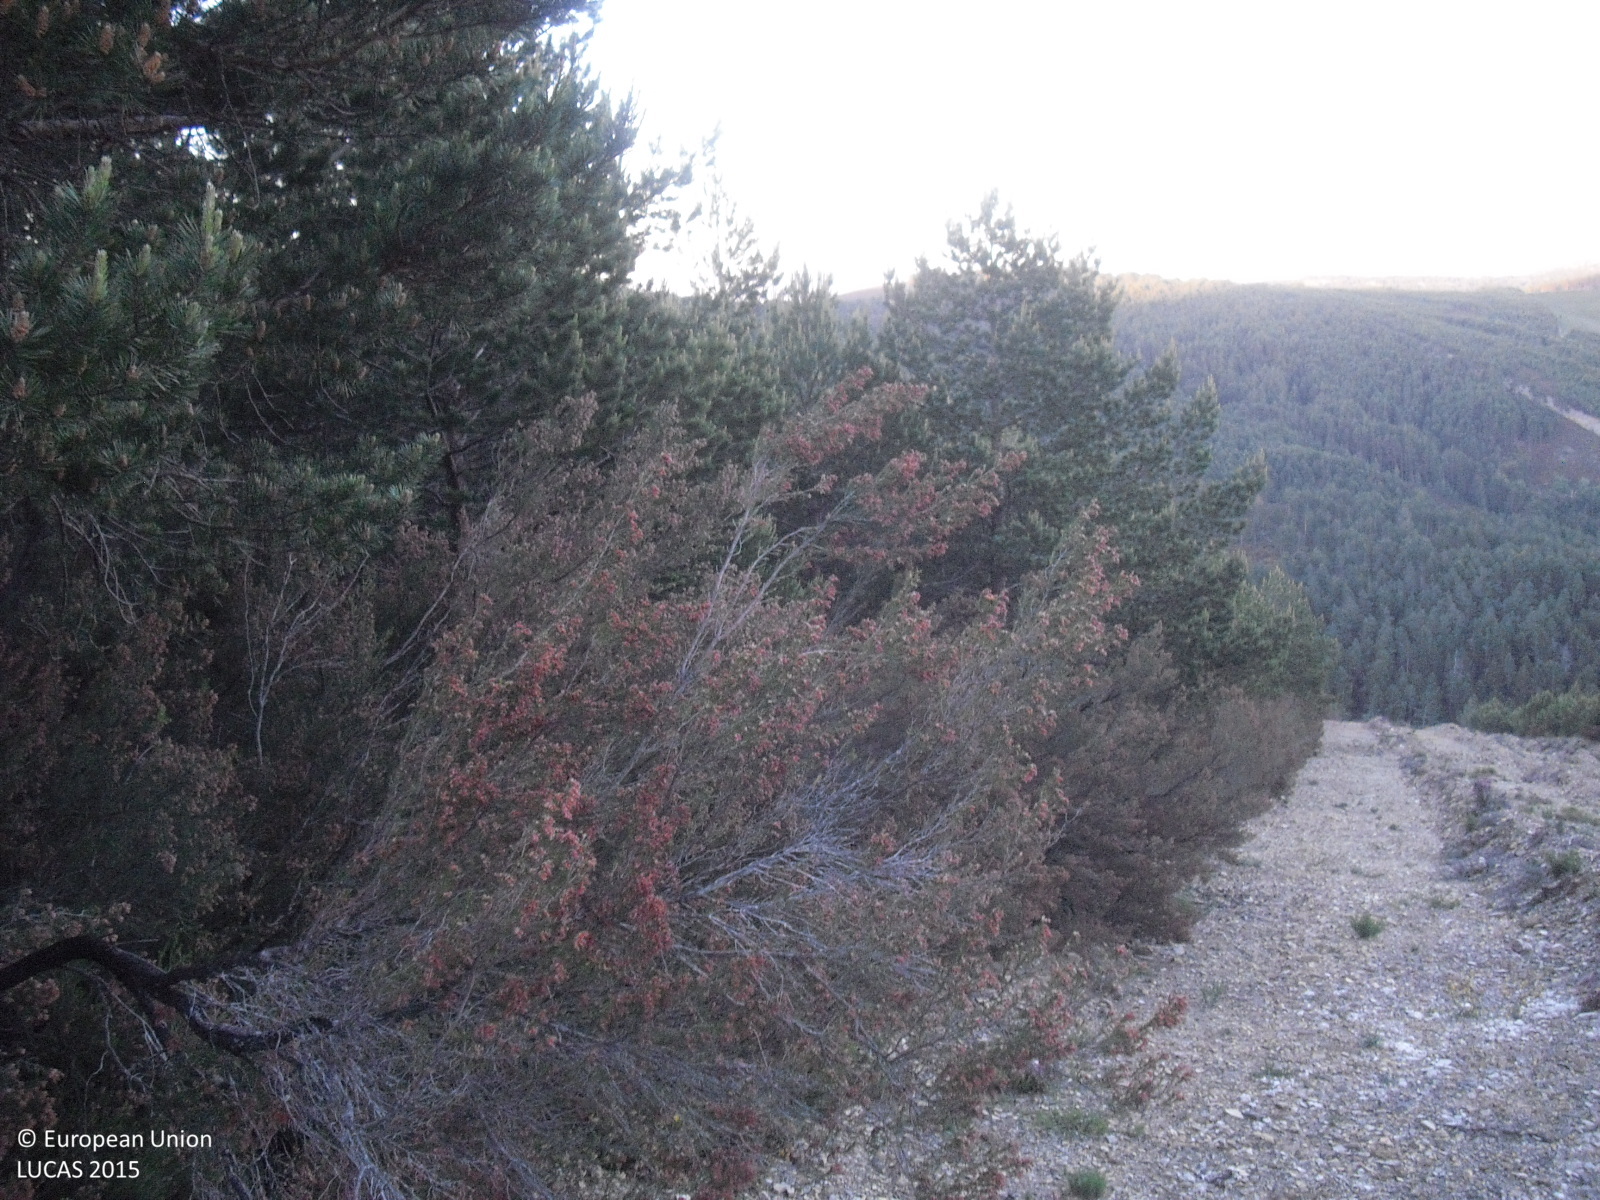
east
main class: Woodland
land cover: Pine dominated coniferous woodland
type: hemiboreal forest and nemoral coniferous forest and mixed broadleaved-coniferous forest
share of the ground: > 75 %
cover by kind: coniferous forest trees 80 %, shrubs 20 %
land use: Forestry
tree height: < 5 m
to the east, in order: Pine dominated coniferous woodland; Shruby margins; Ditches and canals; Paved roads, cycling and walking lanes; Shrubland without tree cover; Pine dominated coniferous woodland
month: May
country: ES
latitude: 42.0332
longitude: -7.3191
